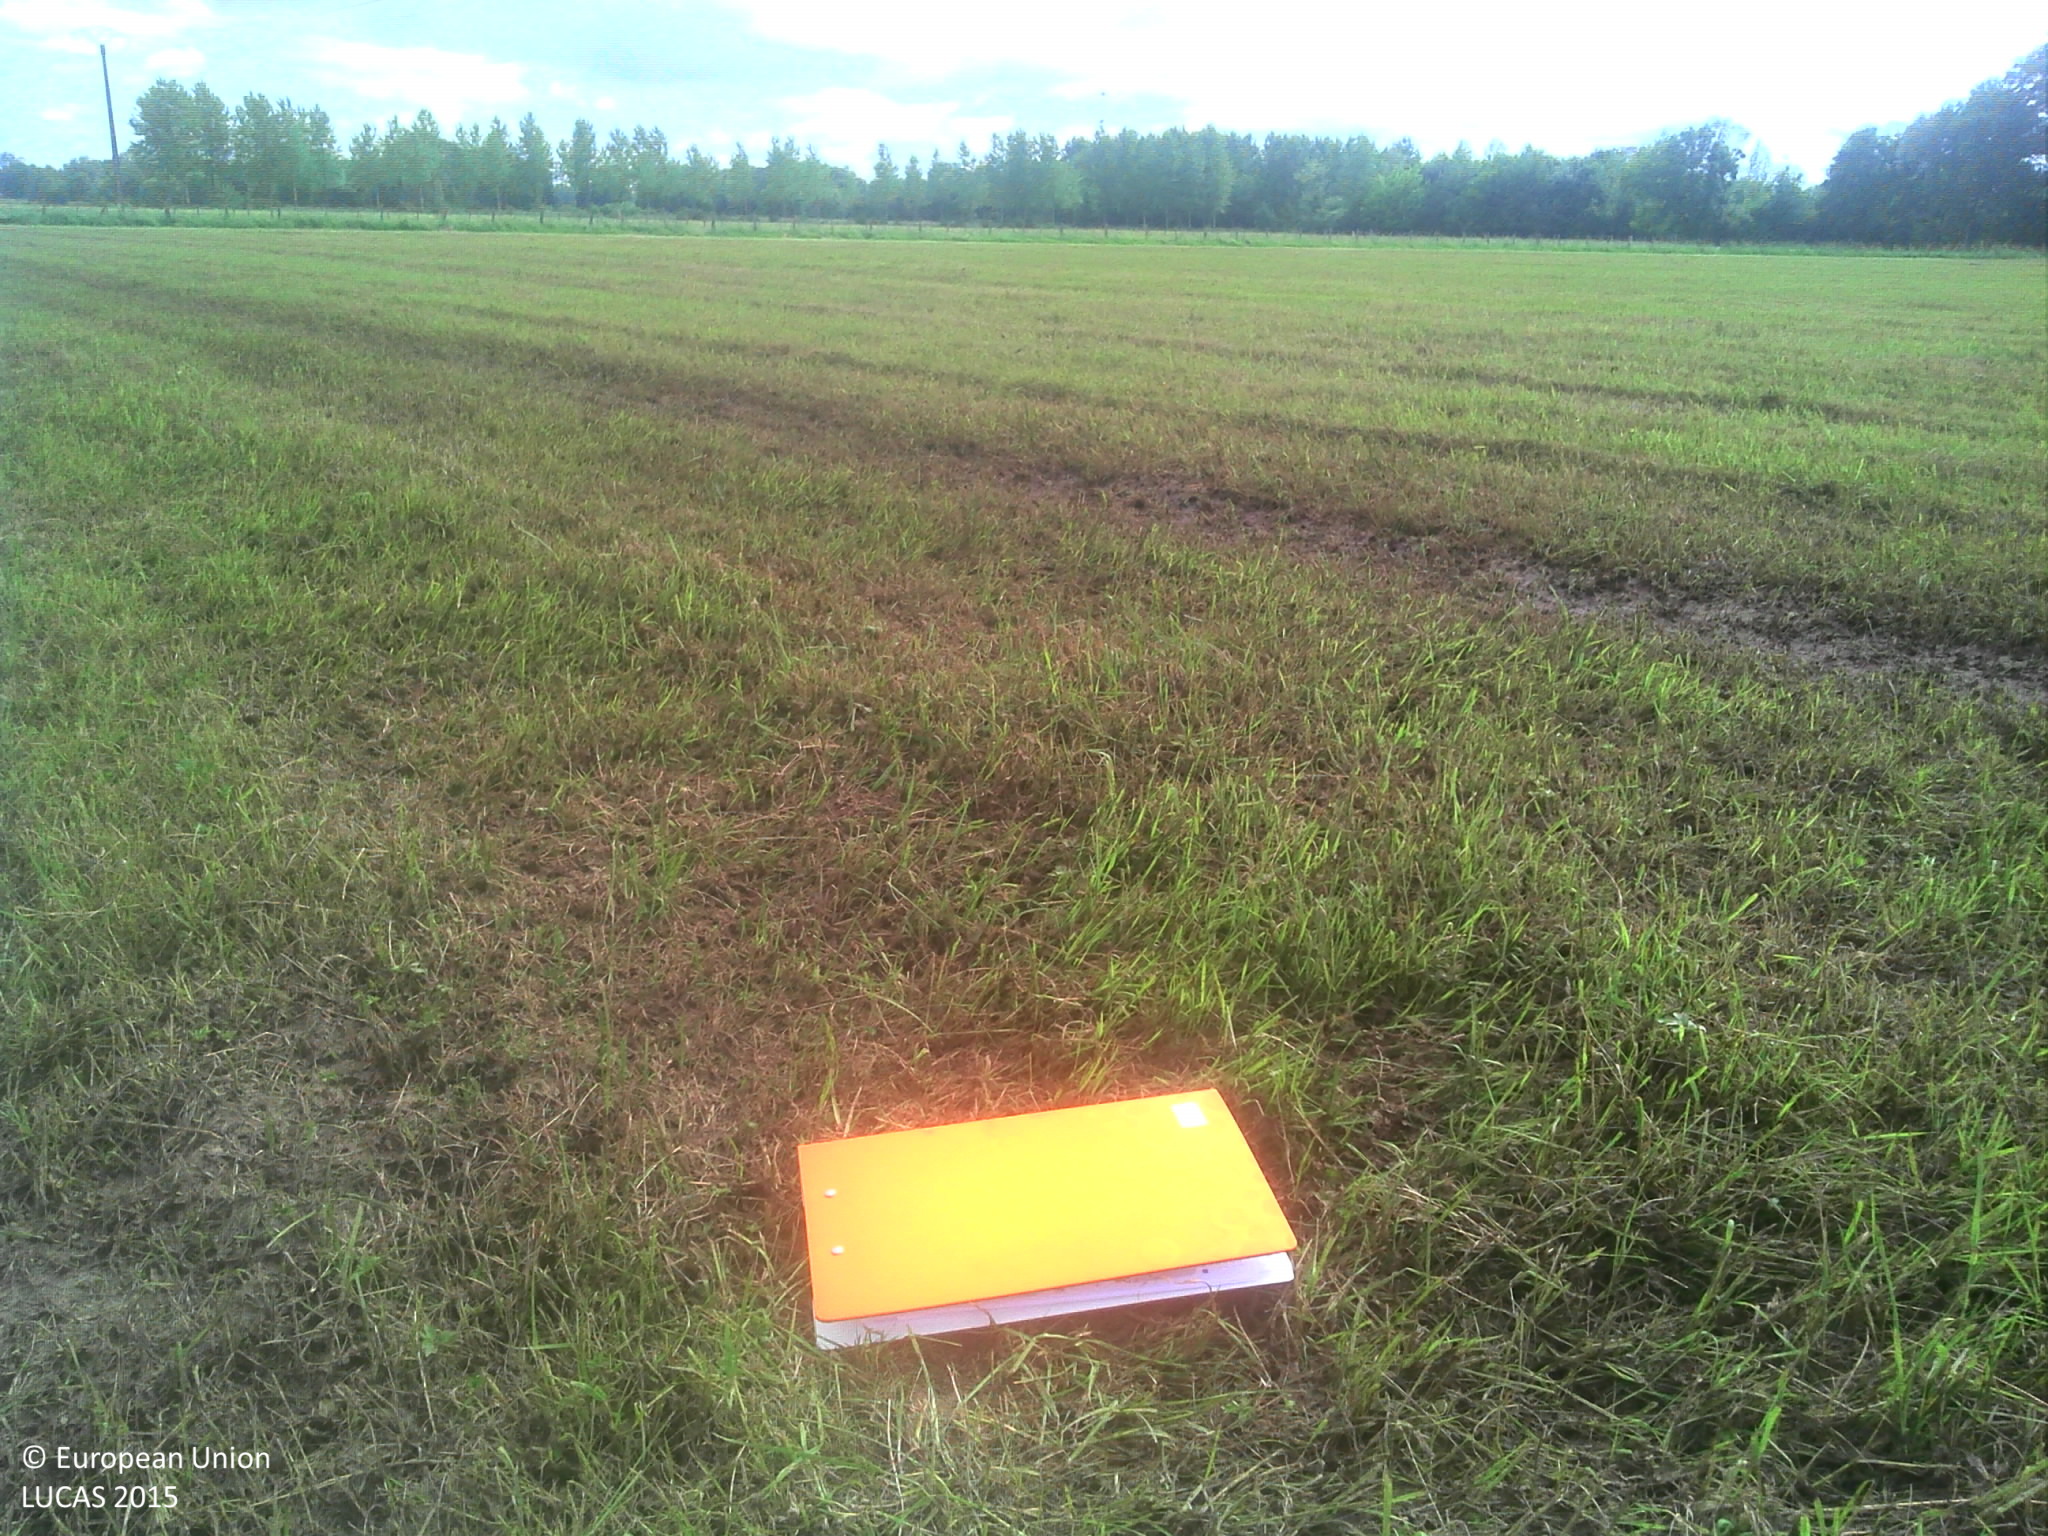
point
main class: Grassland
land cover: Grassland without tree/shrub cover
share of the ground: > 75 %
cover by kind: herbaceous plants 100 %
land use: Agriculture (excluding fallow land and kitchen gardens)
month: June
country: FR
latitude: 48.4931
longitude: 4.7068
